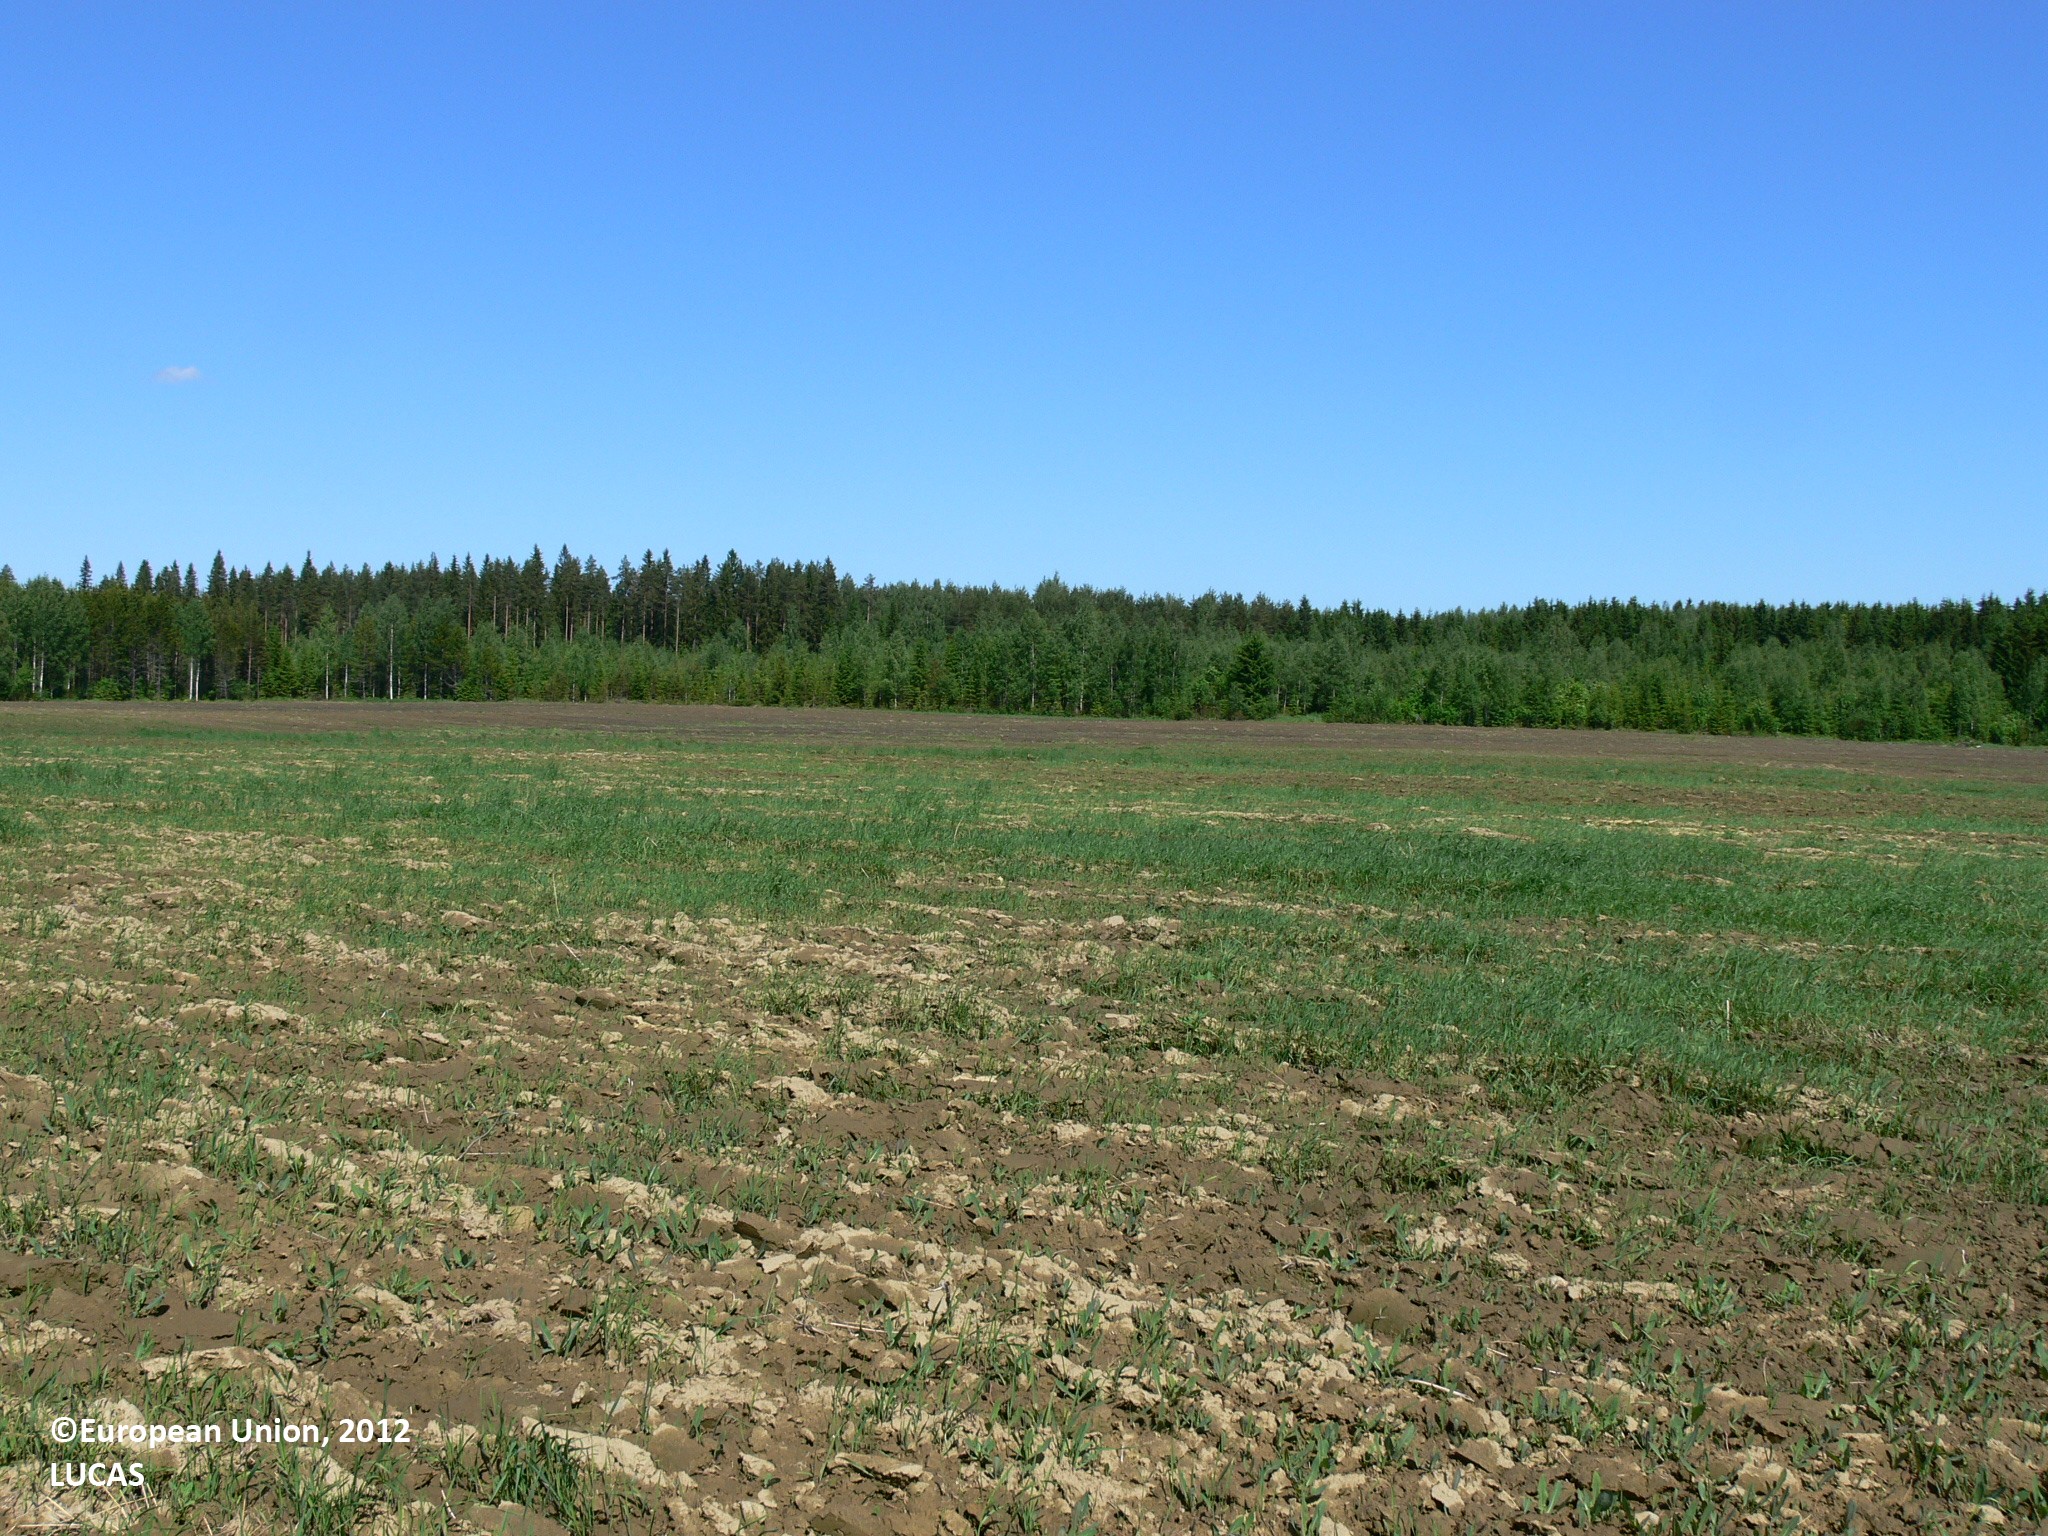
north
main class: Grassland
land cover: Spontaneously vegetated surfaces
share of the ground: < 10 %
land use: Fallow land
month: June
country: FI
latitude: 62.3193
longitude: 30.3657
